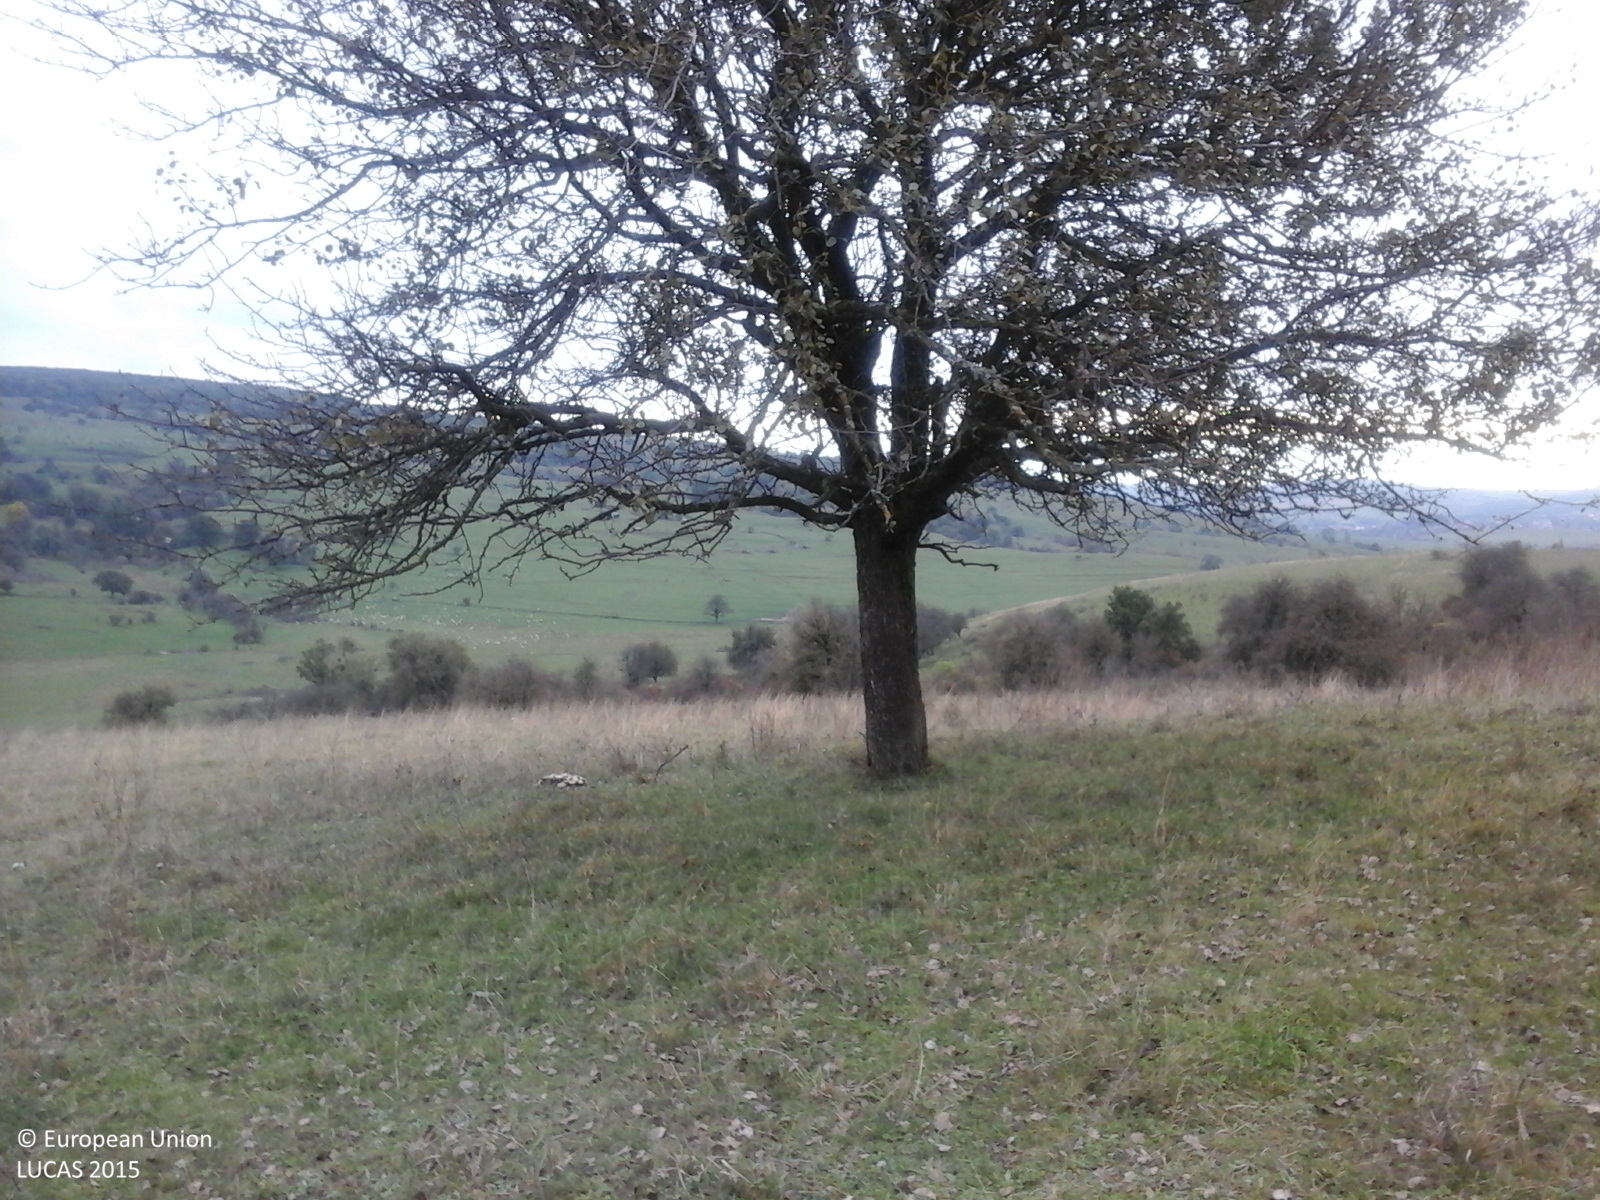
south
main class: Grassland
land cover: Grassland with sparse tree/shrub cover
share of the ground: > 75 %
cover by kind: herbaceous plants 95 %, broadleaved forest trees 5 %
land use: Agriculture (excluding fallow land and kitchen gardens)
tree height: > 5 m
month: October
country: RO
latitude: 45.9501
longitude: 24.8355
